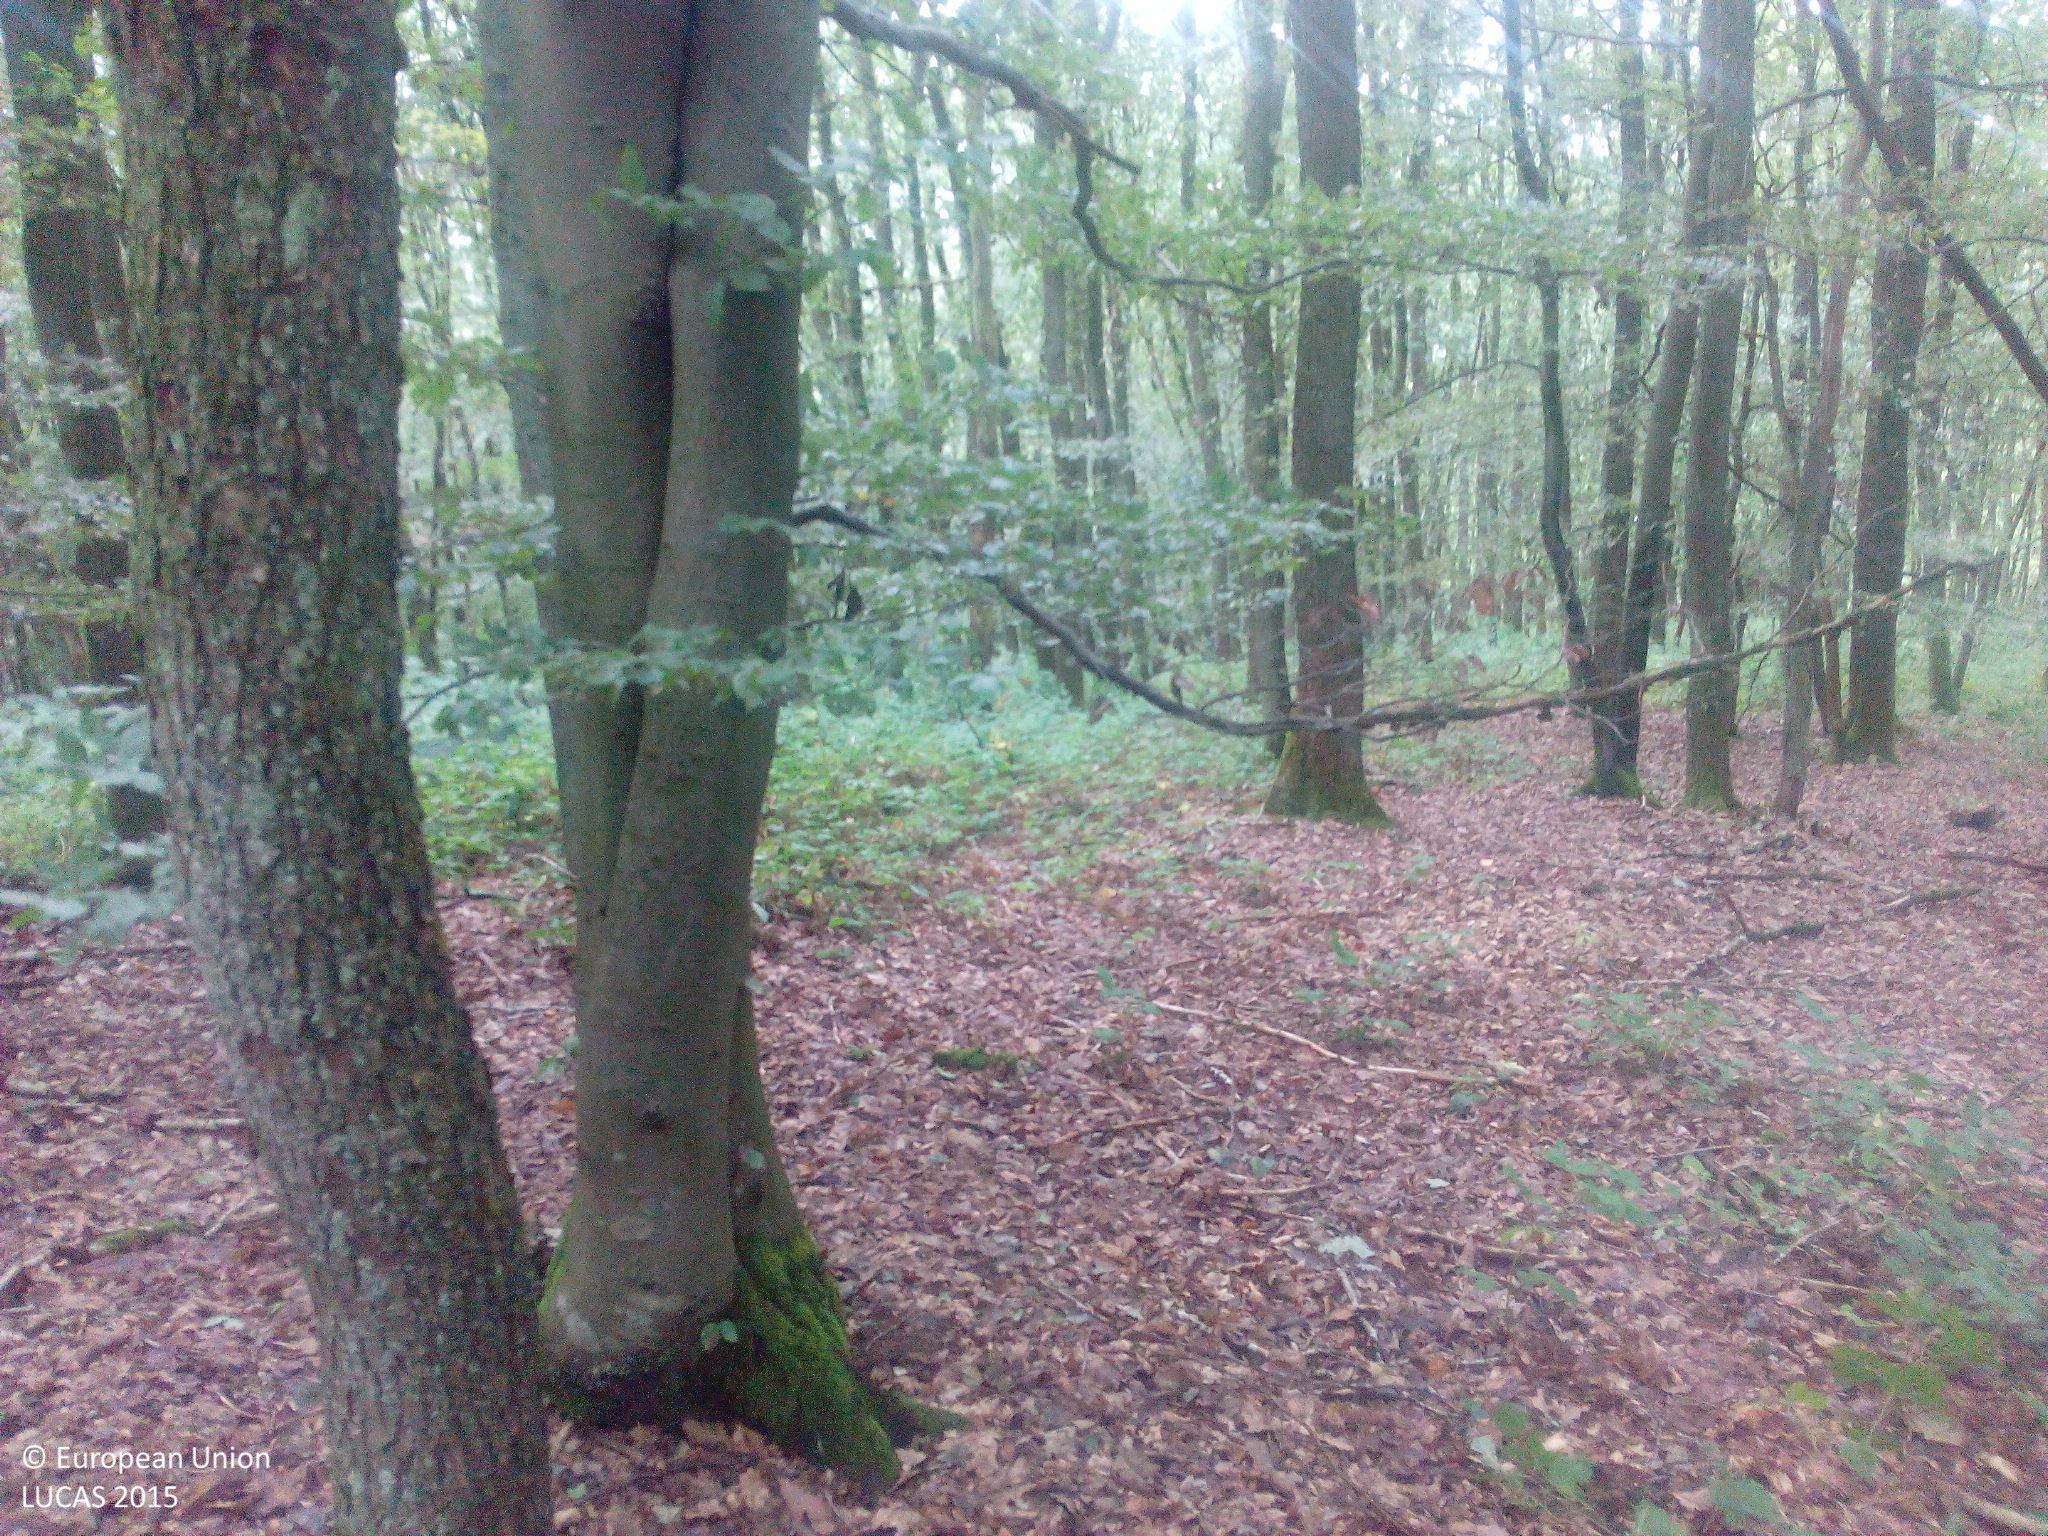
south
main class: Woodland
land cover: Broadleaved woodland
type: mesophytic deciduous forest
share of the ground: > 75 %
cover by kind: broadleaved forest trees 100 %
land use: Forestry
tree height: > 5 m
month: August
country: DE
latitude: 50.1779
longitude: 6.2886
